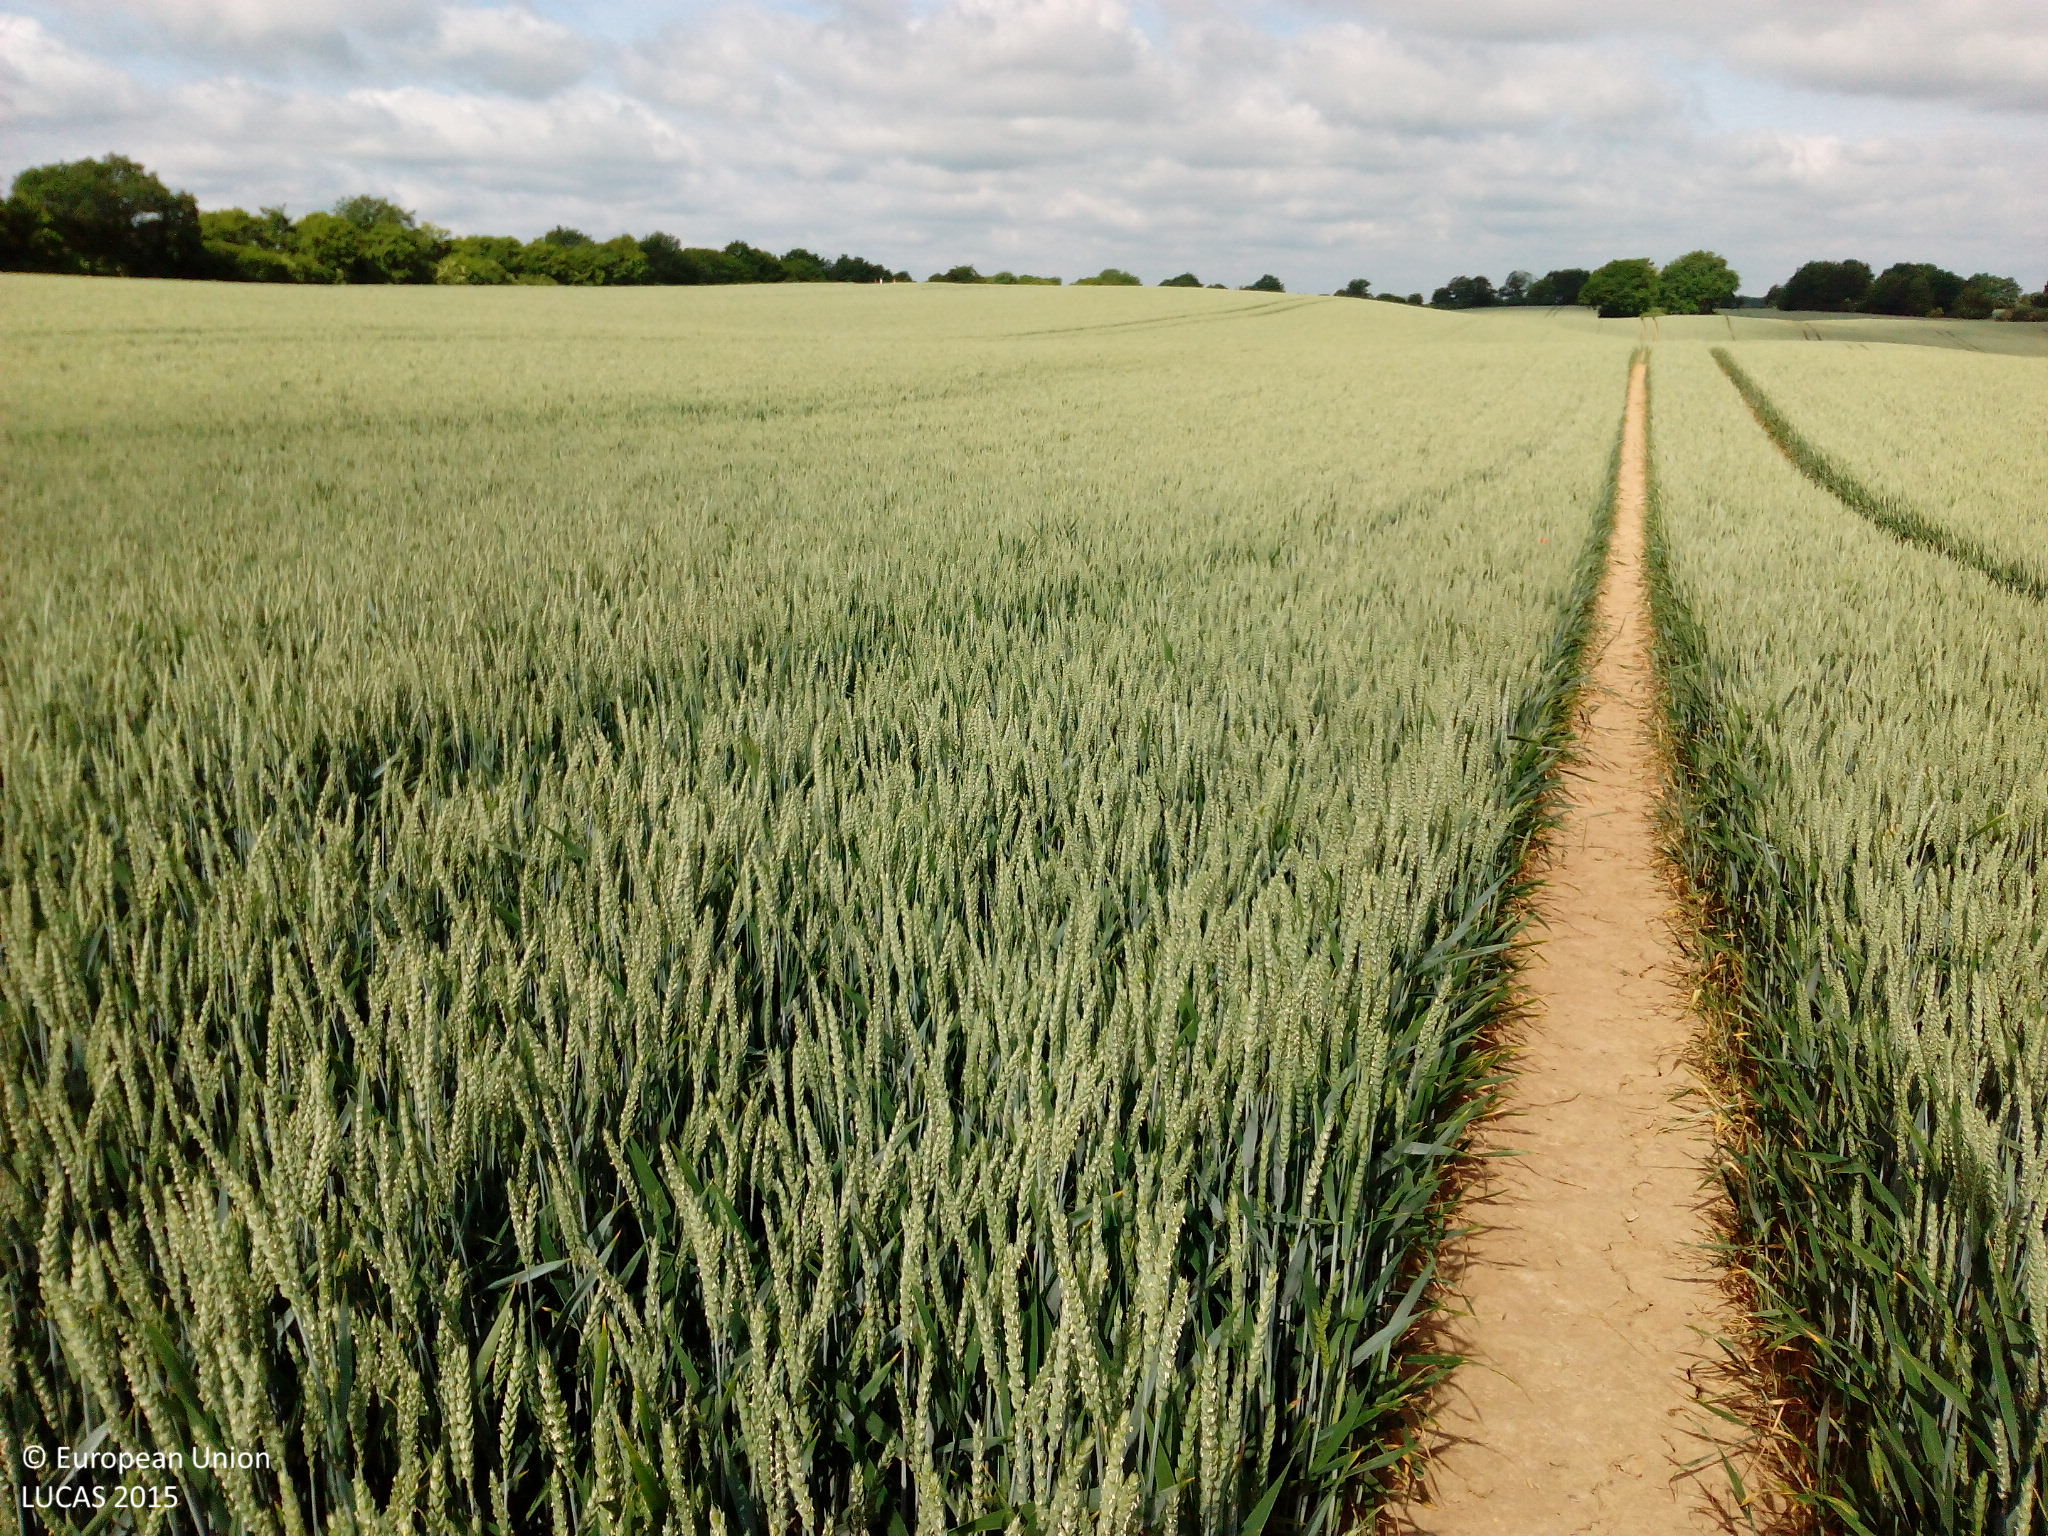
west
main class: Cropland
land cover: Common wheat
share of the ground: > 75 %
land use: Agriculture (excluding fallow land and kitchen gardens)
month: June
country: DE
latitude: 53.7561
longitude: 11.1370
